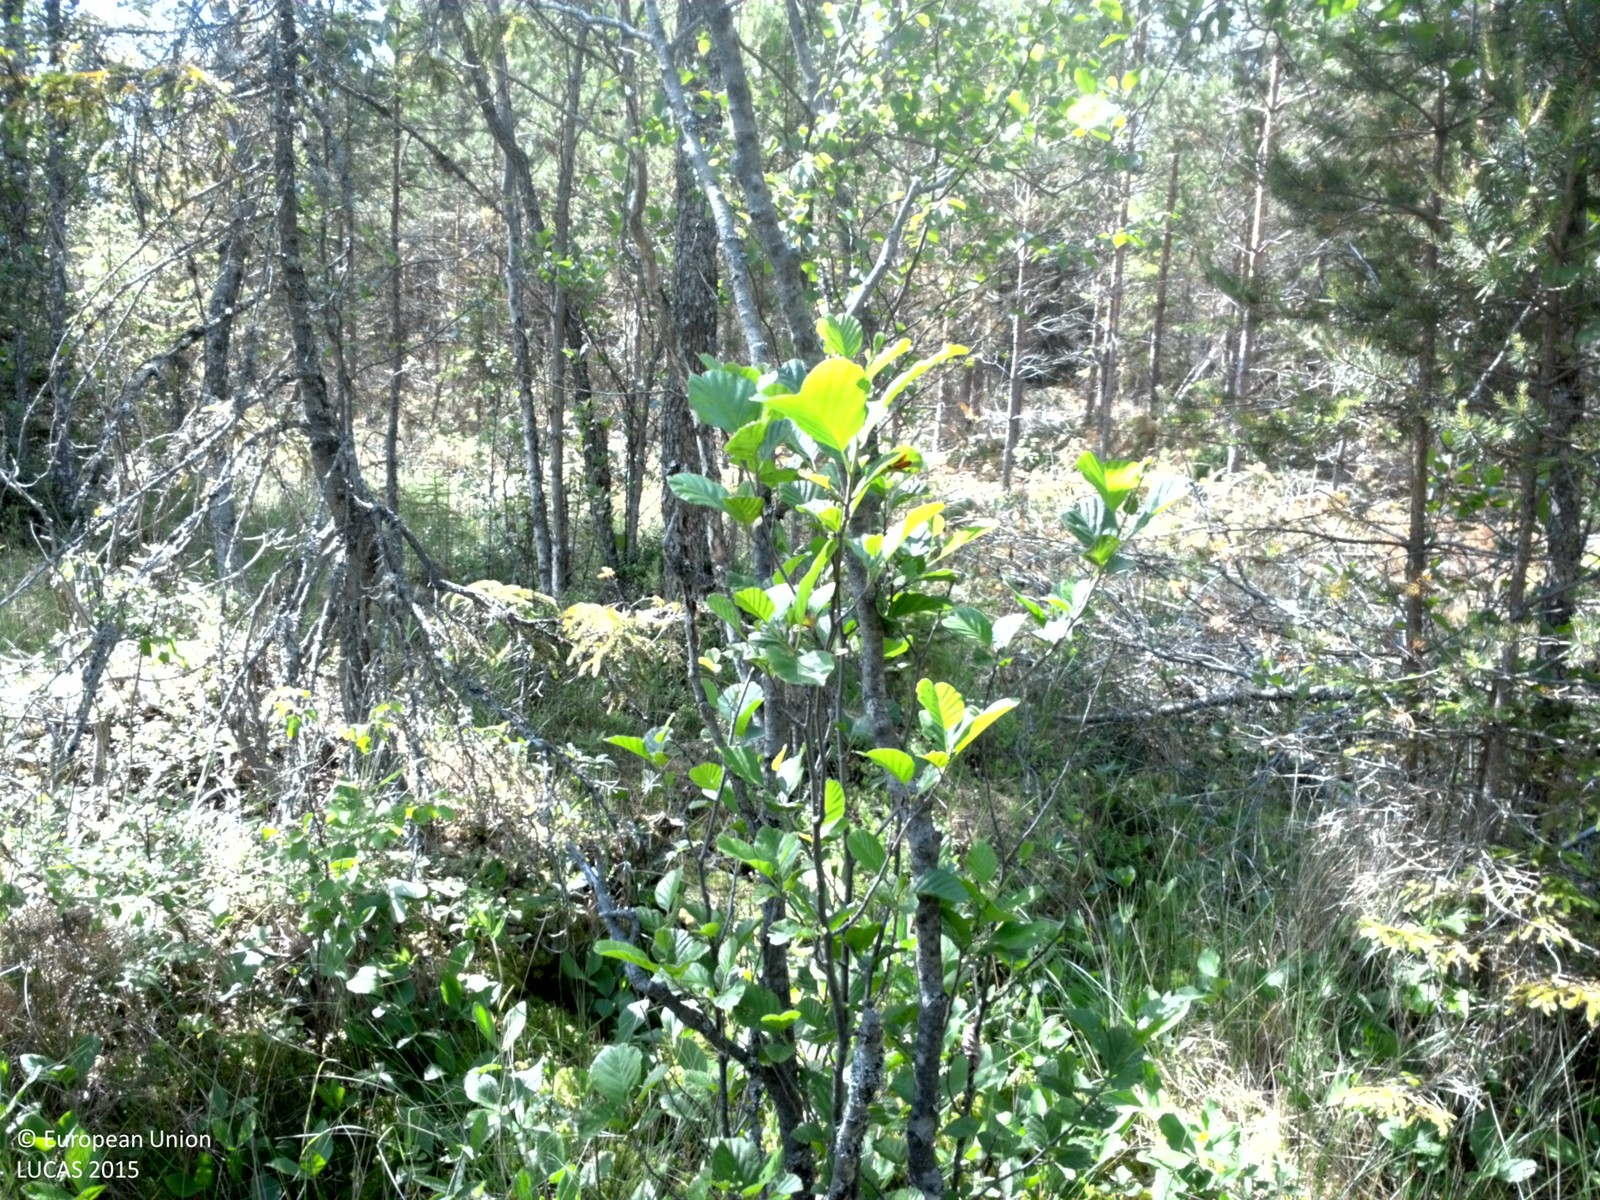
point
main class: Woodland
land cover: Pine dominated mixed woodland
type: boreal forest
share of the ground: 25 - 50 %
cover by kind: lichens and mosses 50 %, coniferous forest trees 30 %, broadleaved forest trees 10 %, herbaceous plants 10 %
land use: Forestry
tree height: > 5 m
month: July
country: SE
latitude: 60.0066
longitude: 17.0038
